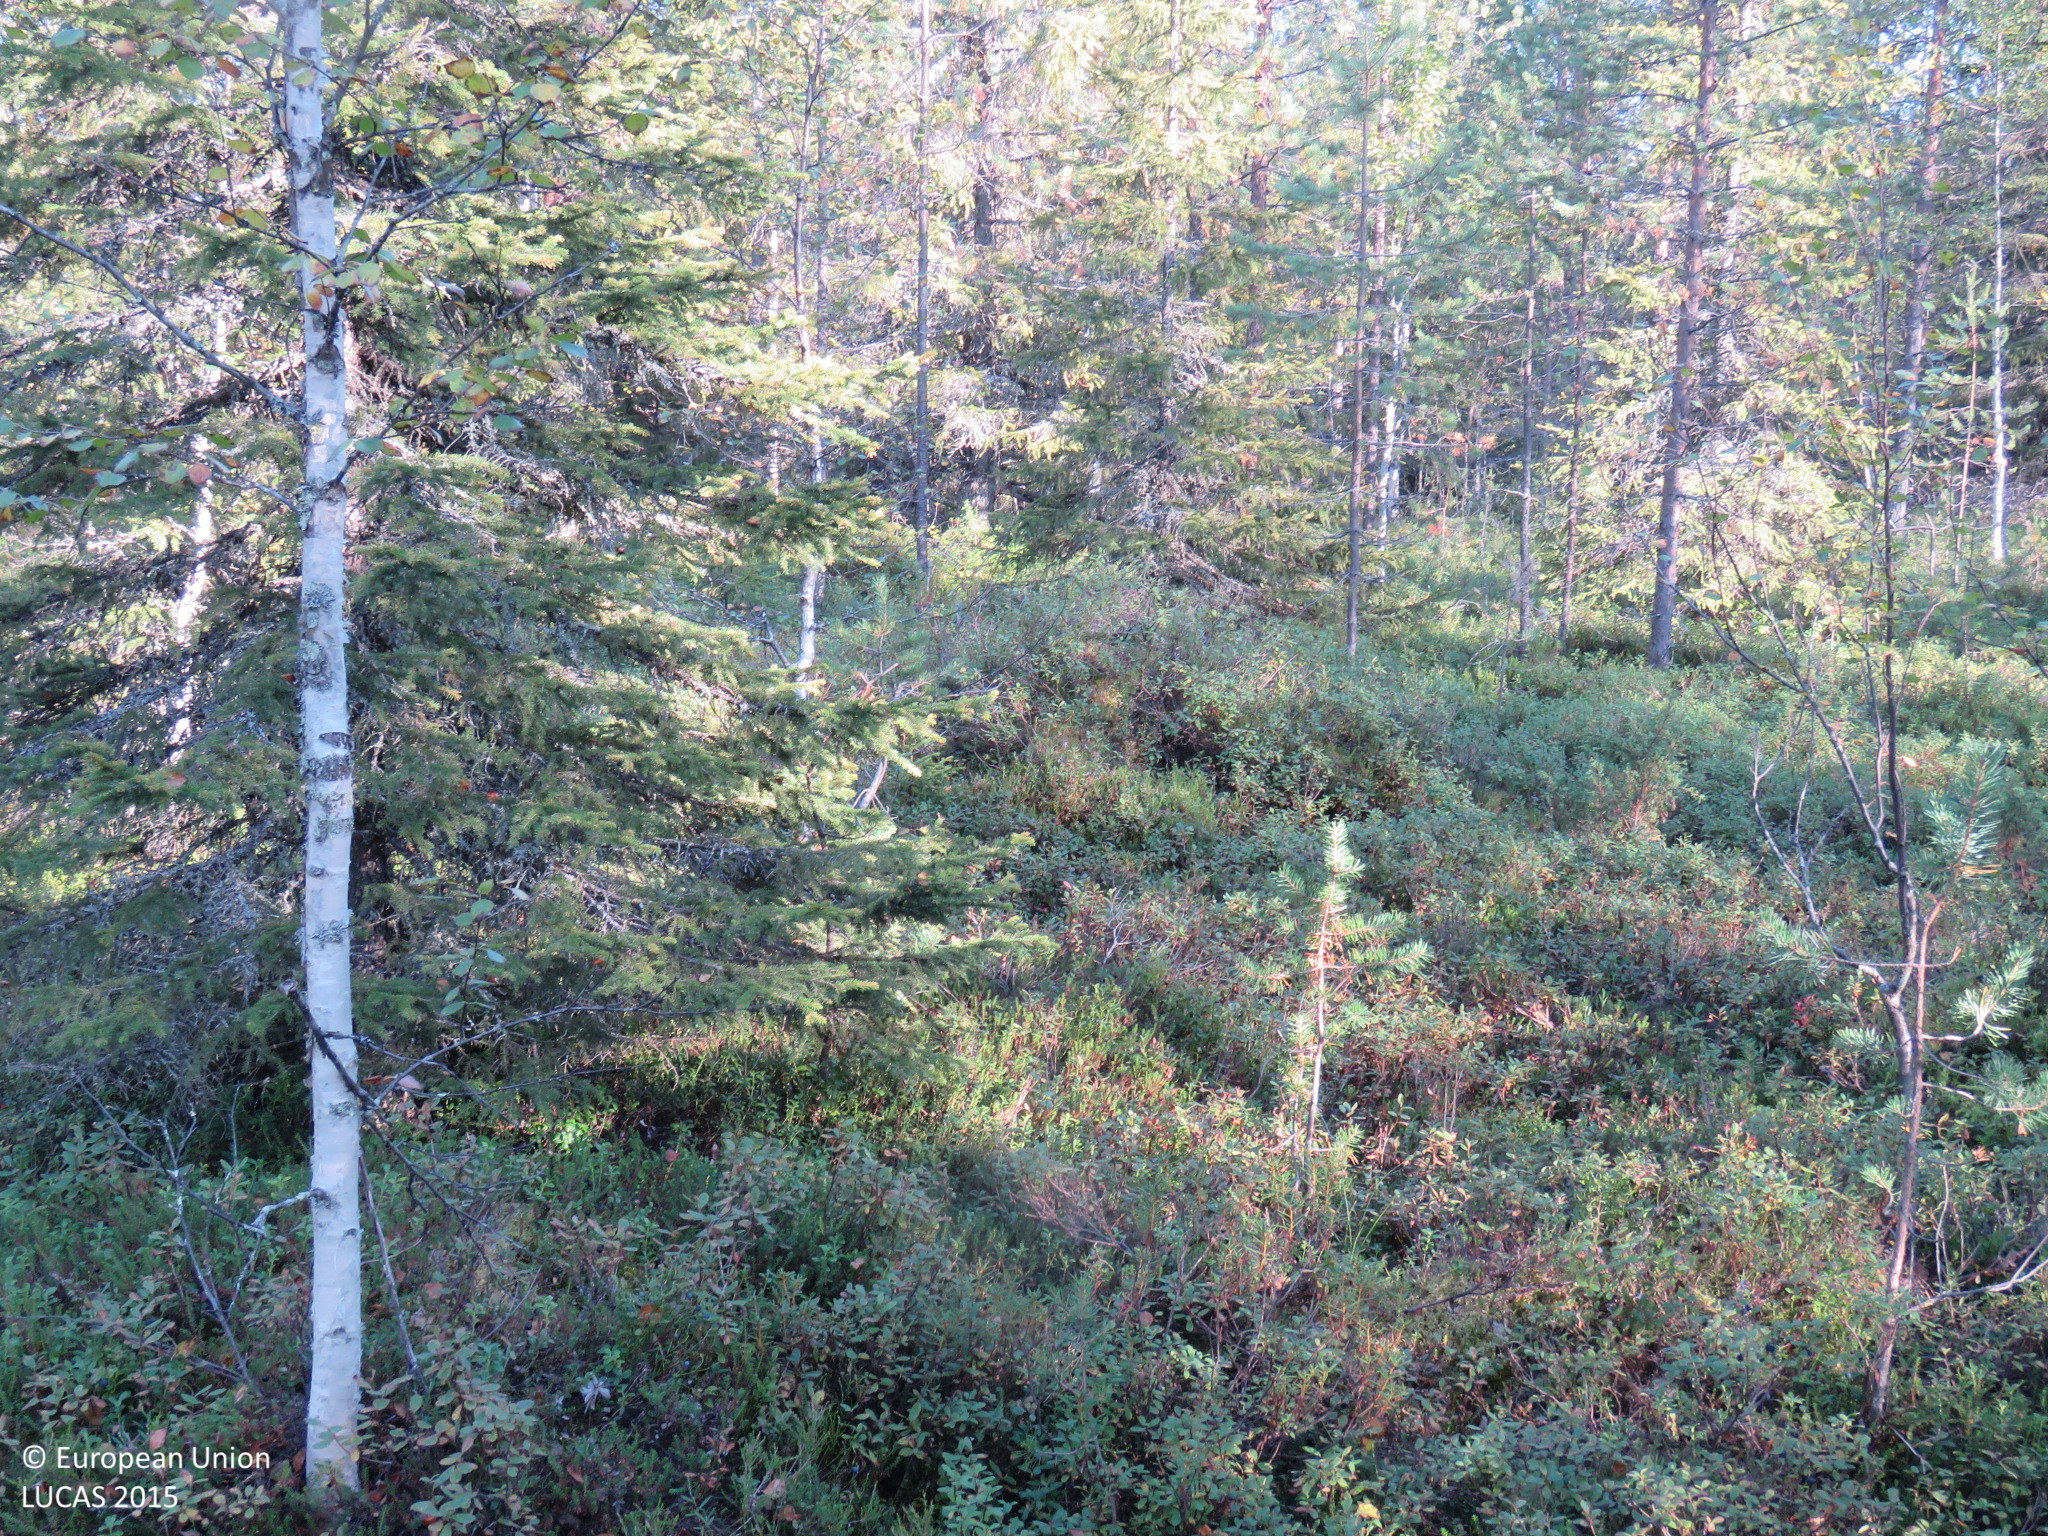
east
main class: Woodland
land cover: Other mixed woodland
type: boreal forest
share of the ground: > 75 %
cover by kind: coniferous forest trees 50 %, broadleaved forest trees 25 %, shrubs 20 %, lichens and mosses 5 %
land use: Forestry
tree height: > 5 m
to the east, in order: Other mixed woodland; Ditches and canals; Pine dominated mixed woodland; Ditches and canals; Other coniferous woodland; Ditches and canals; Other coniferous woodland; Ditches and canals; Other coniferous woodland; Ditches and canals; Pine dominated coniferous woodland; Ditches and canals; Other coniferous woodland; Pine dominated mixed woodland; Ditches and canals; Pine dominated mixed woodland
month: September
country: FI
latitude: 65.5267
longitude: 27.5897
